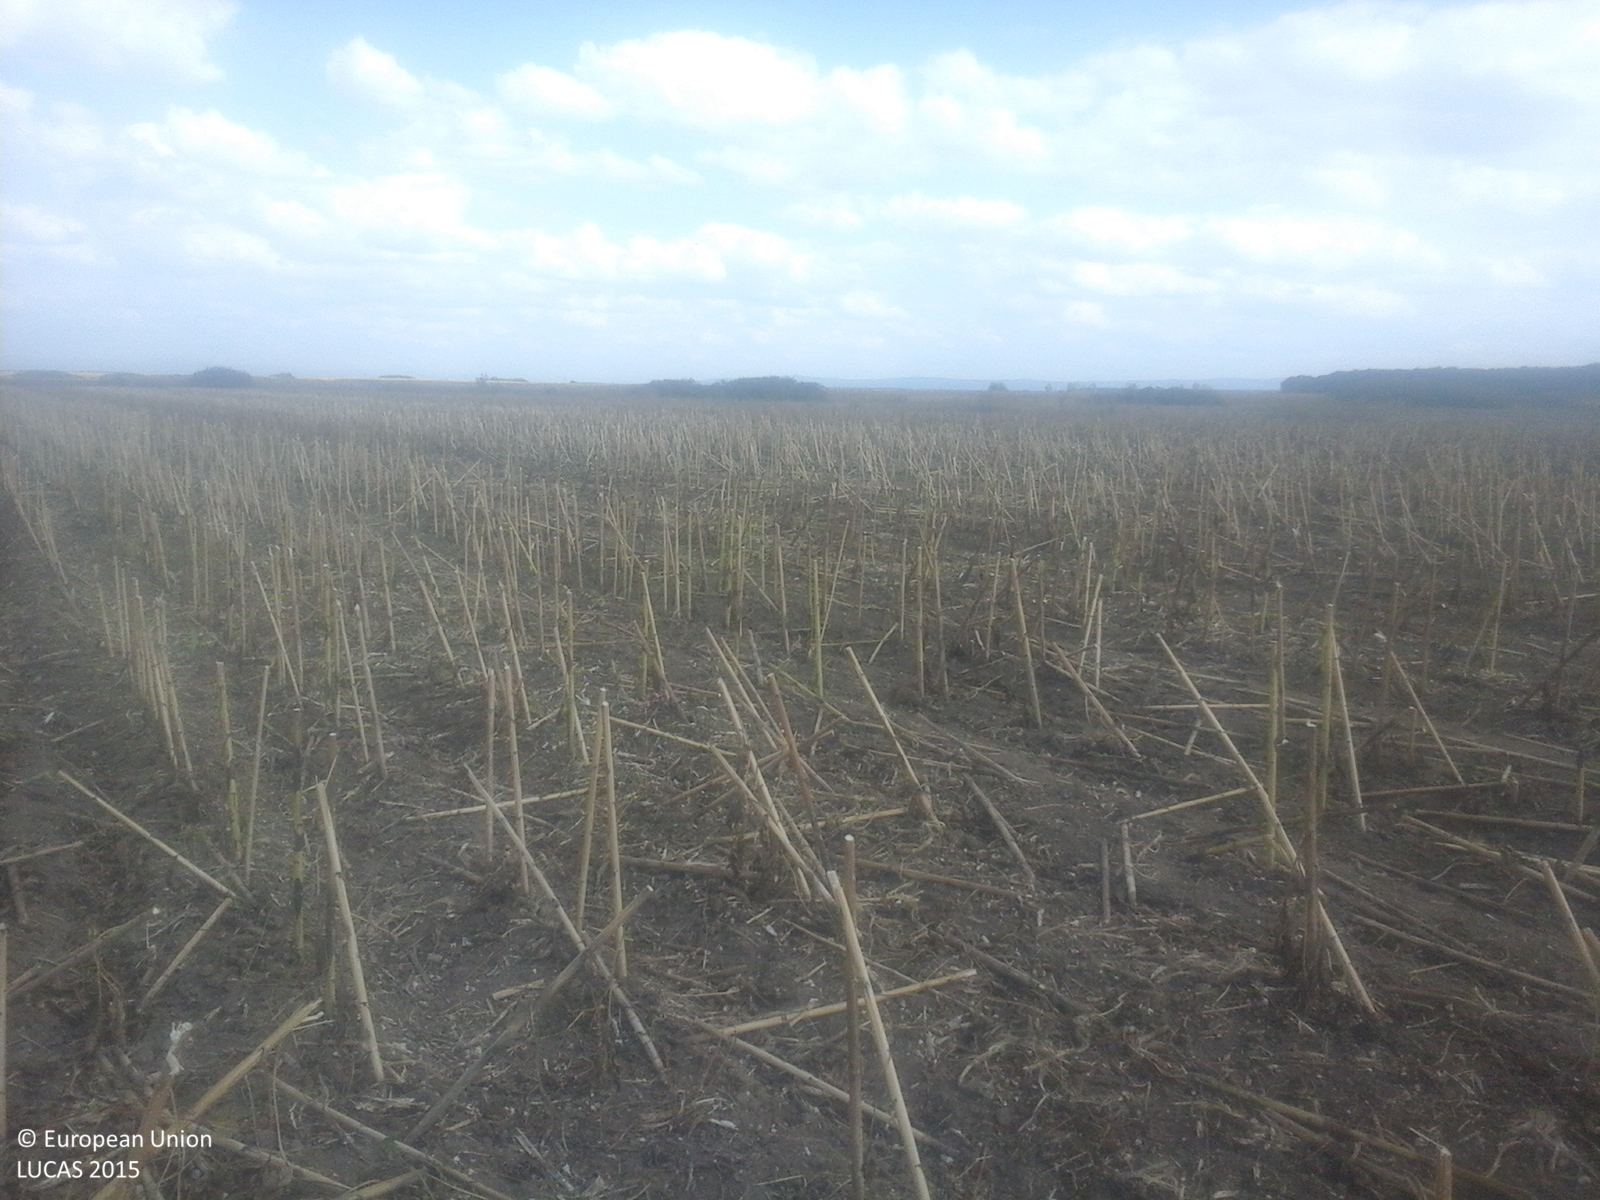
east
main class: Cropland
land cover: Sunflower
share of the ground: > 75 %
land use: Agriculture (excluding fallow land and kitchen gardens)
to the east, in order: Sunflower; Shruby margins; Tracks; Shruby margins; Common wheat; Tracks; Grass margins; Maize
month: September
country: RO
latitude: 47.6677
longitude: 22.6994
